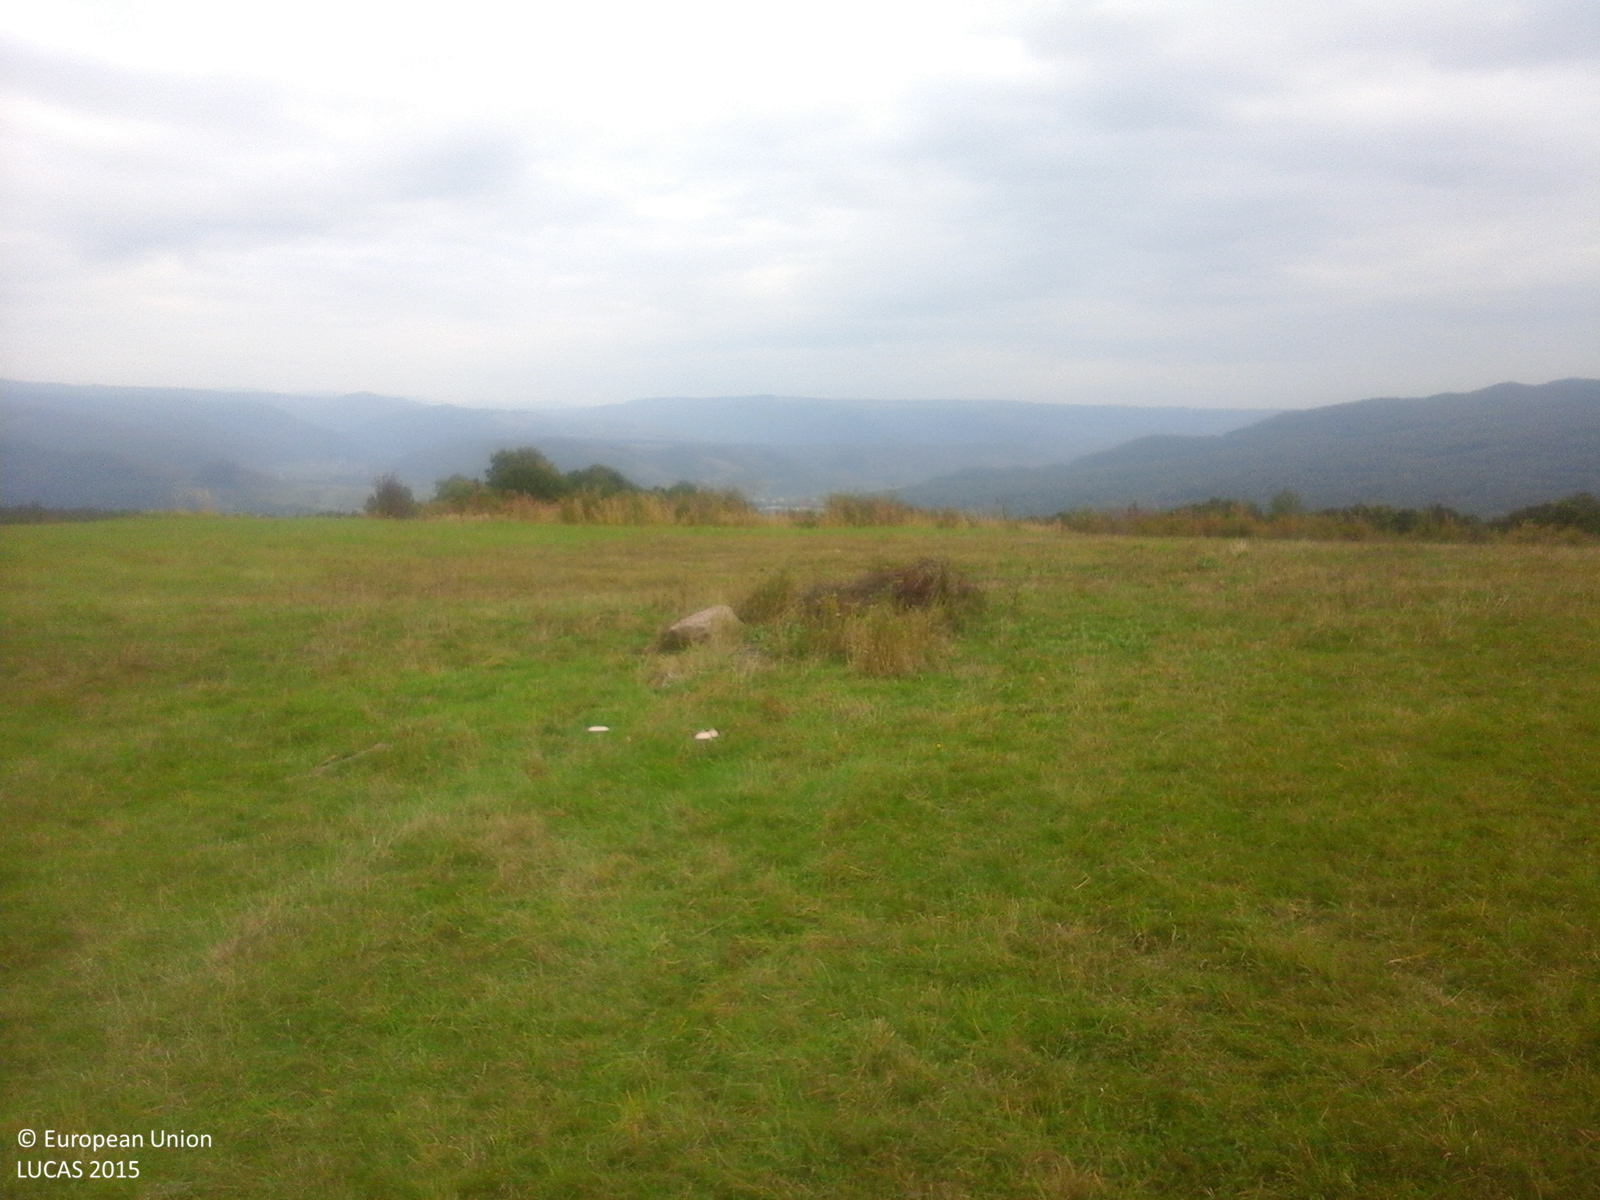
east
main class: Grassland
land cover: Grassland without tree/shrub cover
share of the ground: > 75 %
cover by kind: herbaceous plants 100 %
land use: Agriculture (excluding fallow land and kitchen gardens)
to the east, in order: Grassland without tree/shrub cover; Spontaneously vegetated surfaces; Grassland with sparse tree/shrub cover; Shrubland with sparse tree cover; Grassland with sparse tree/shrub cover
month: October
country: RO
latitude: 46.5836
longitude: 25.0148
